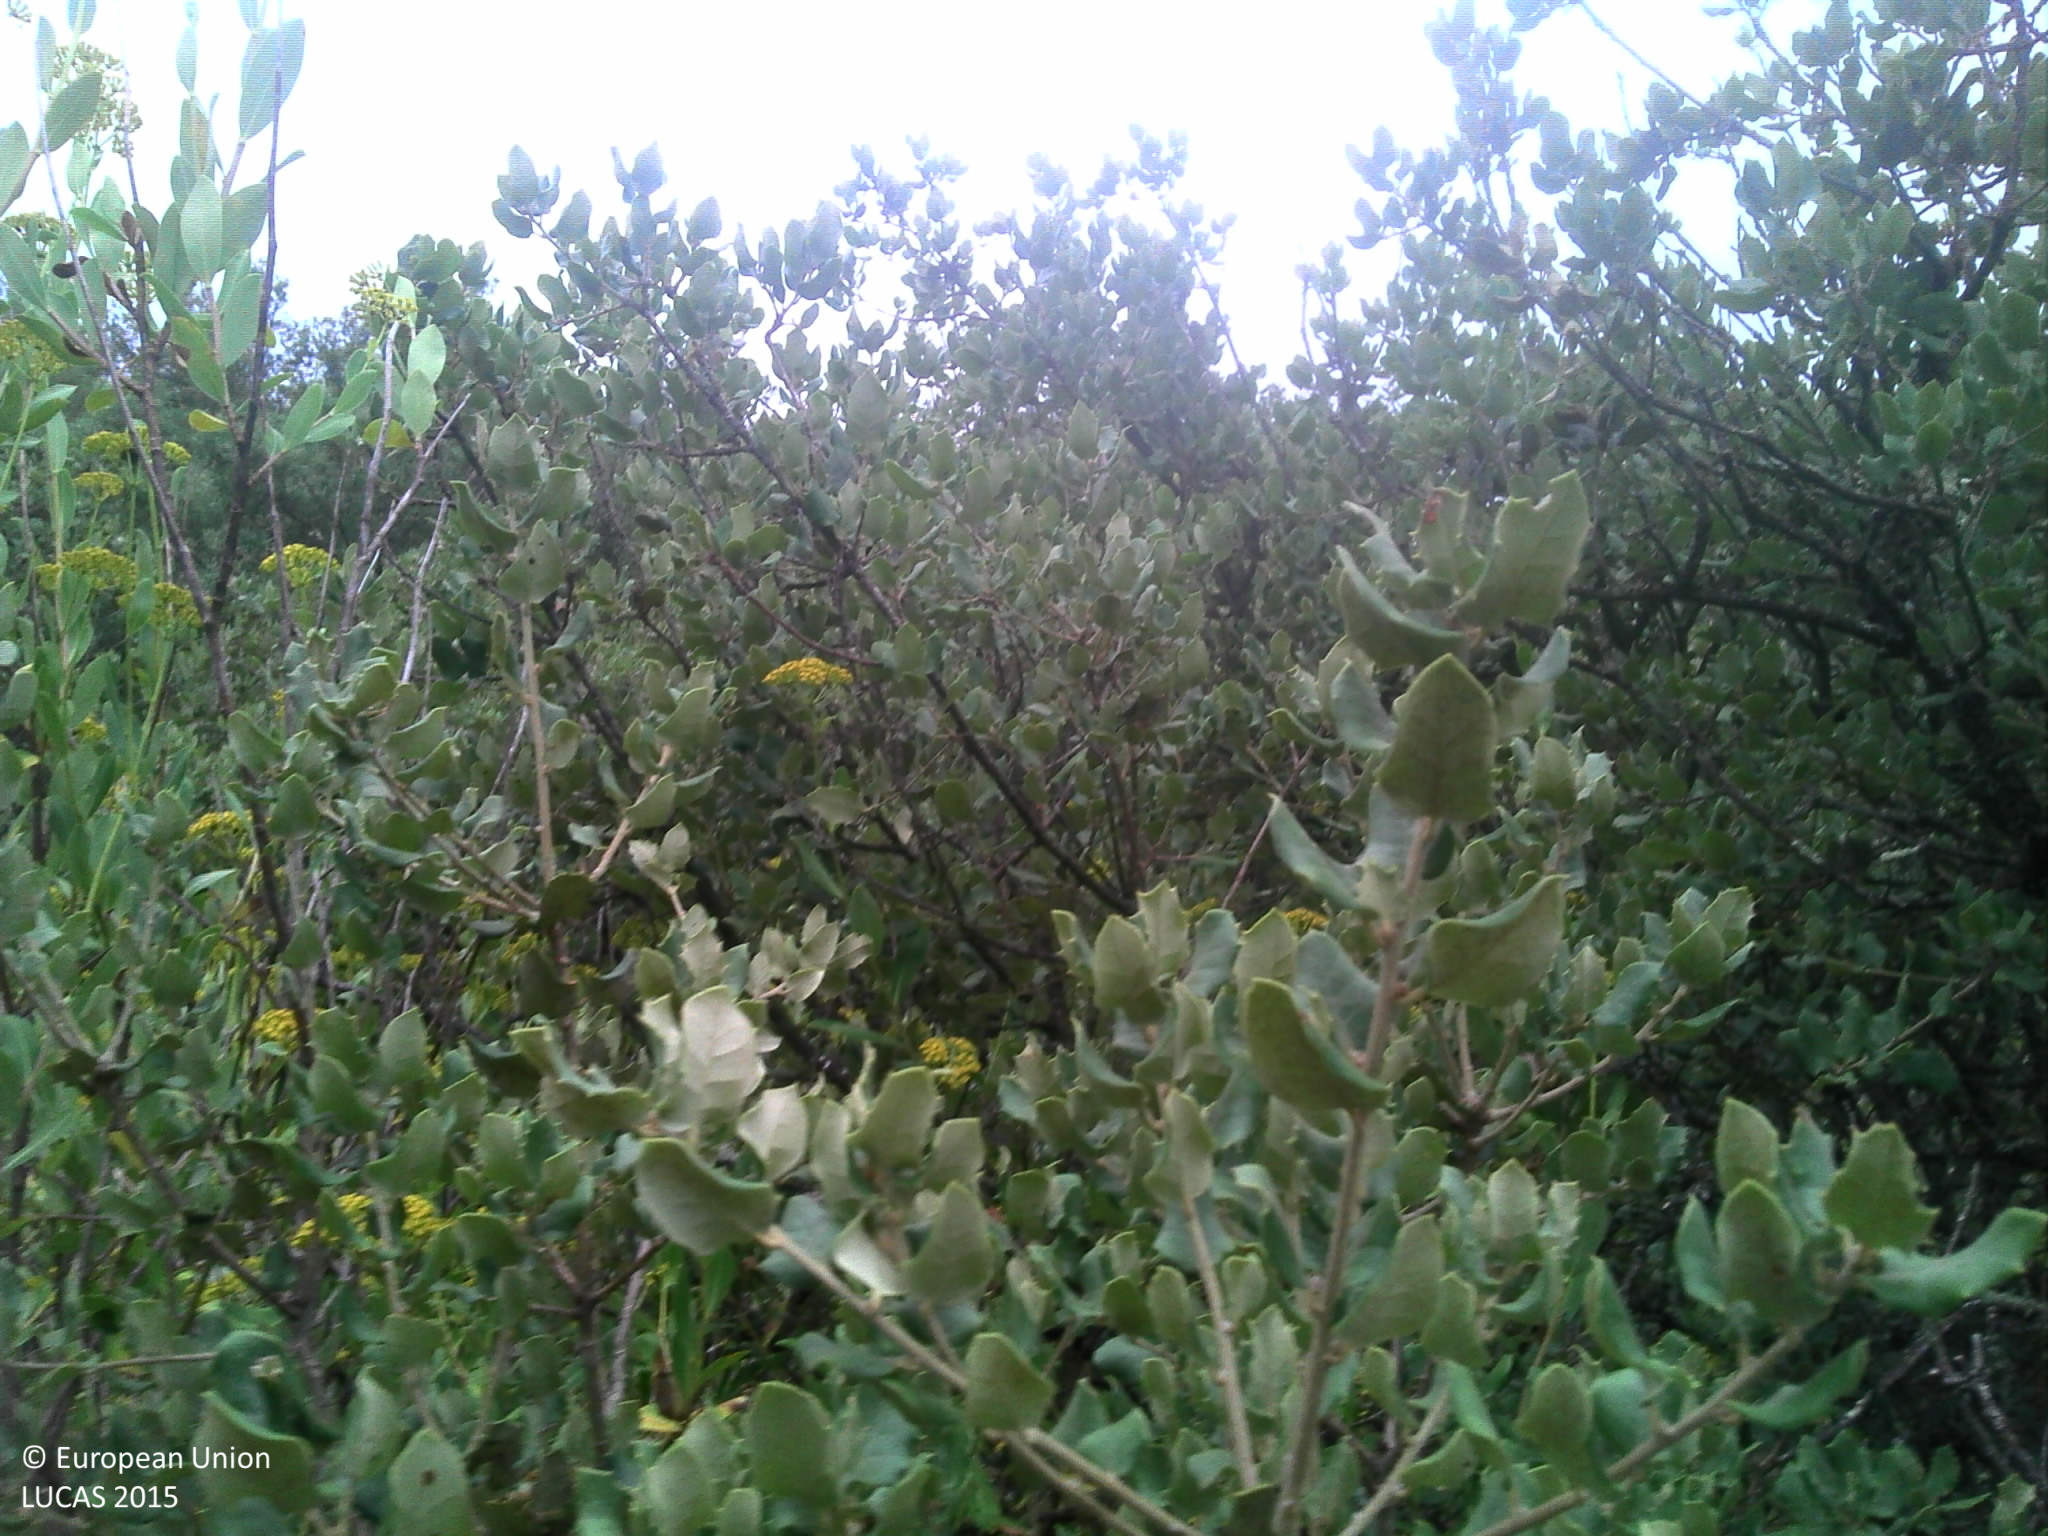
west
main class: Woodland
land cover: Broadleaved woodland
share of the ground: > 75 %
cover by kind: broadleaved forest trees 60 %, unconsolidated bare surface 20 %, shrubs 10 %, herbaceous plants 10 %
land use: Forestry
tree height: < 5 m
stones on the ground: 10 - 25 %
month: July
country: FR
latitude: 43.5816
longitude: 5.0436
